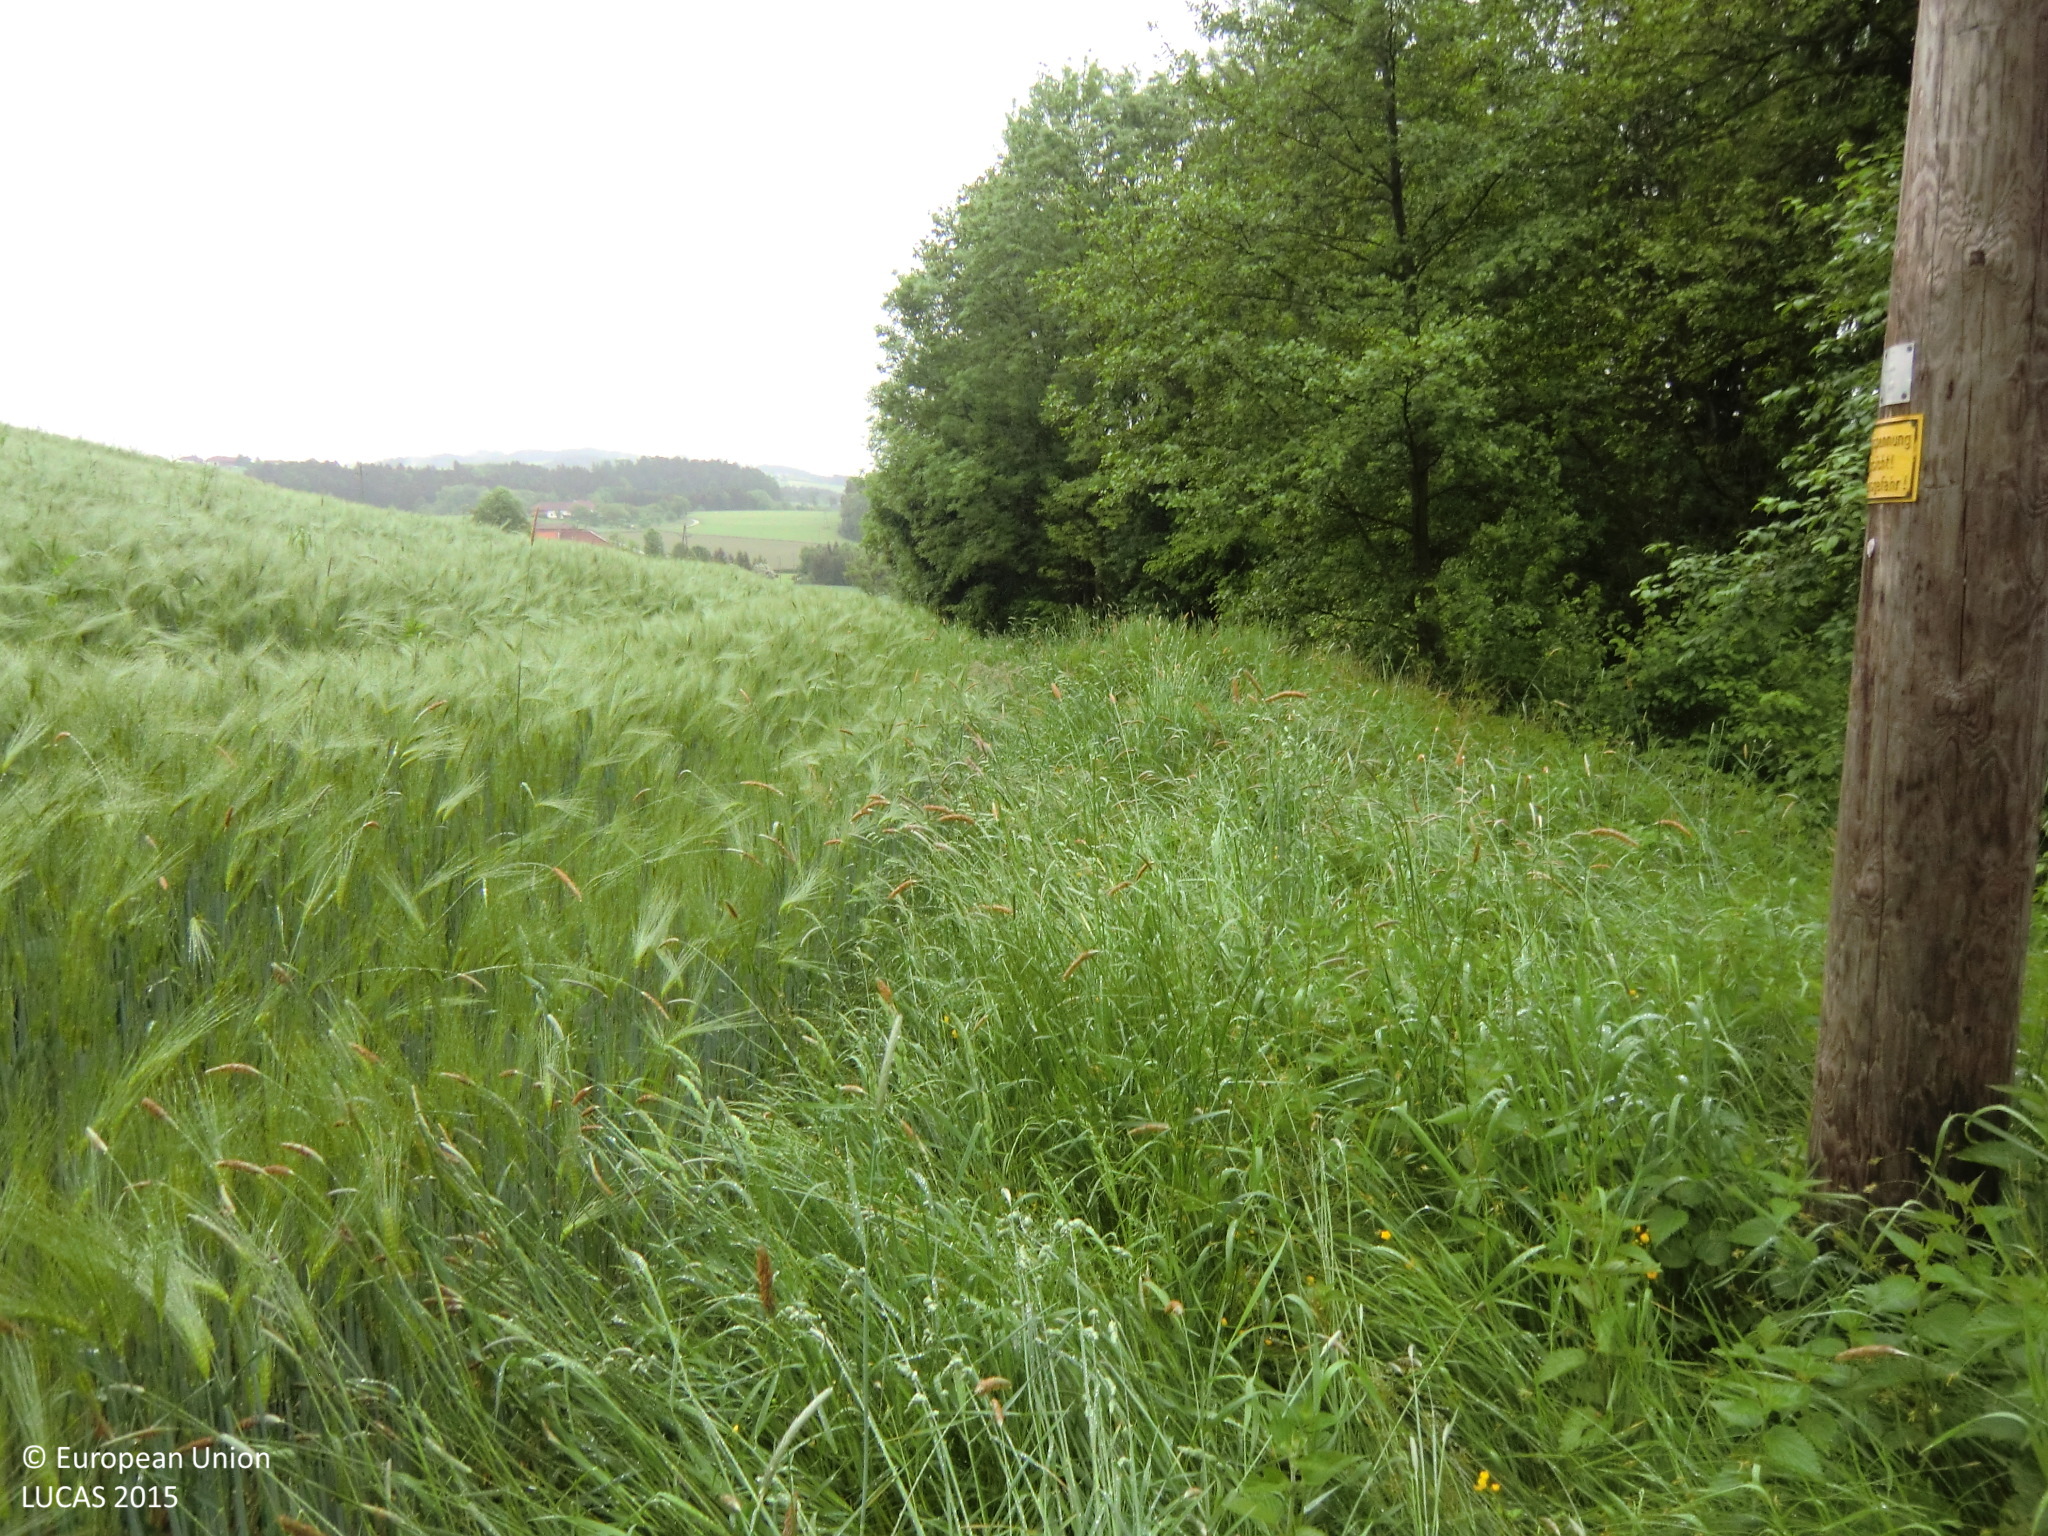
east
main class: Grassland
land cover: Grassland without tree/shrub cover
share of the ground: > 75 %
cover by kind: herbaceous plants 100 %
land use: Agriculture (excluding fallow land and kitchen gardens)
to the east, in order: Grassland without tree/shrub cover; Electric lines; Grassland without tree/shrub cover; Barley; Grassland without tree/shrub cover; Electric lines; Grassland without tree/shrub cover
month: May
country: AT
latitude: 48.3101
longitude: 14.5444
